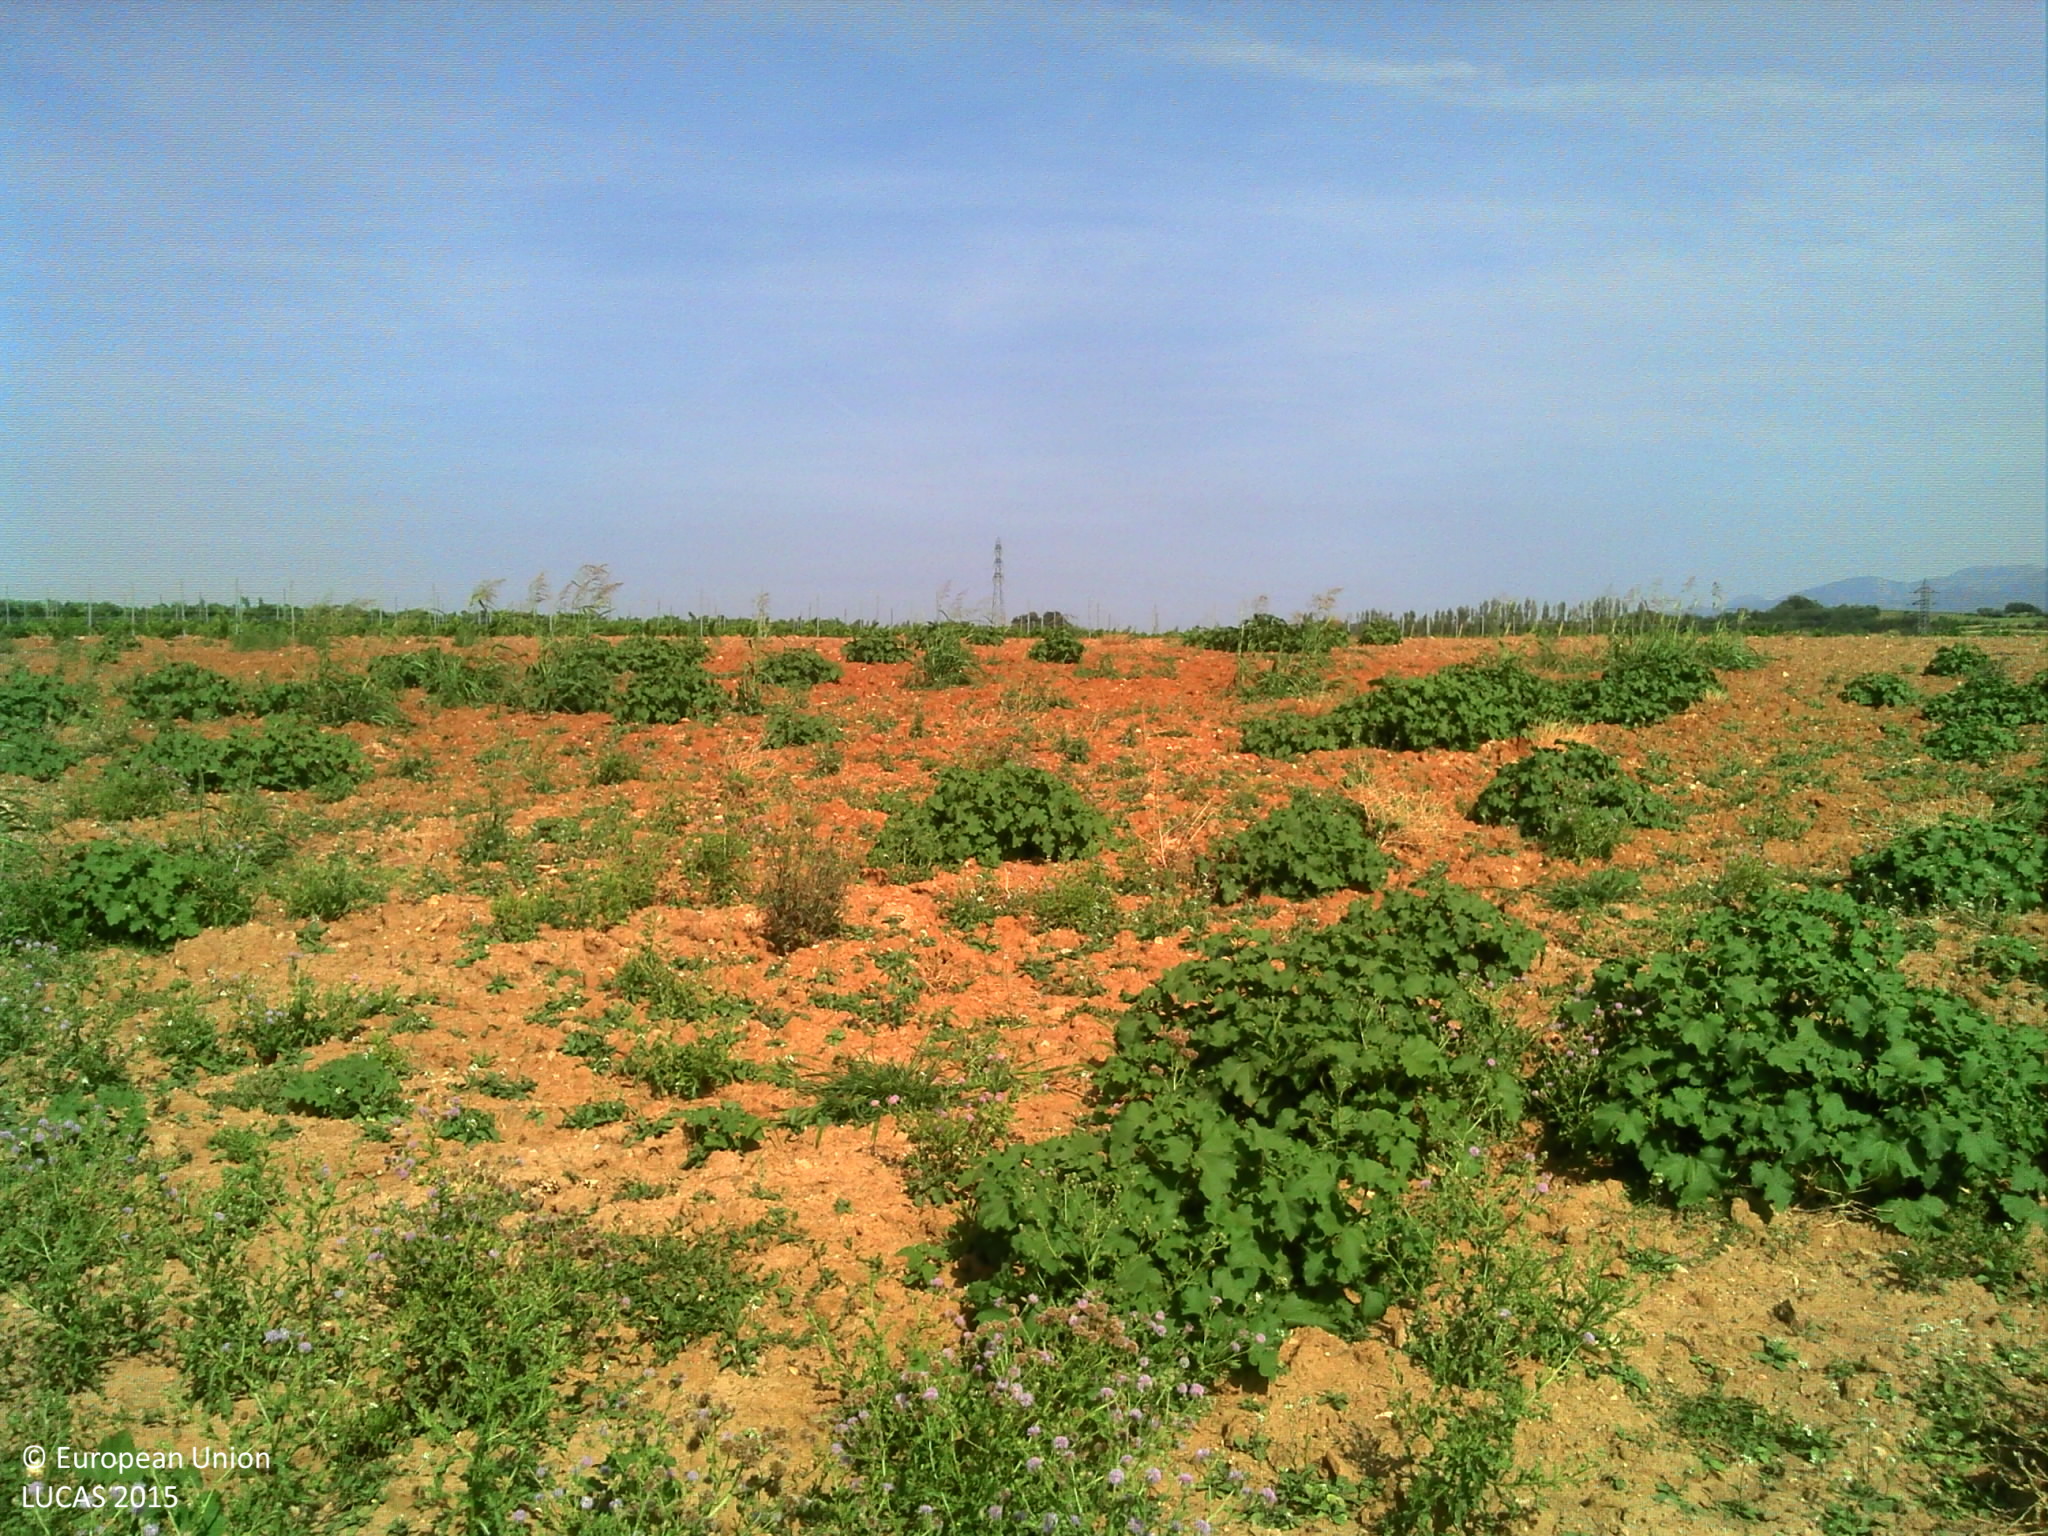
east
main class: Grassland
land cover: Spontaneously vegetated surfaces
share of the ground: 50 - 75 %
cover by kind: herbaceous plants 75 %, unconsolidated bare surface 25 %
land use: Fallow land
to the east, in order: Spontaneously vegetated surfaces; Other bare soil; Vineyards; Paved roads, cycling and walking lanes; Shrubland without tree cover; Grassland without tree/shrub cover; Tracks; Grassland without tree/shrub cover
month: July
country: FR
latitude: 42.6139
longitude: 2.7831
